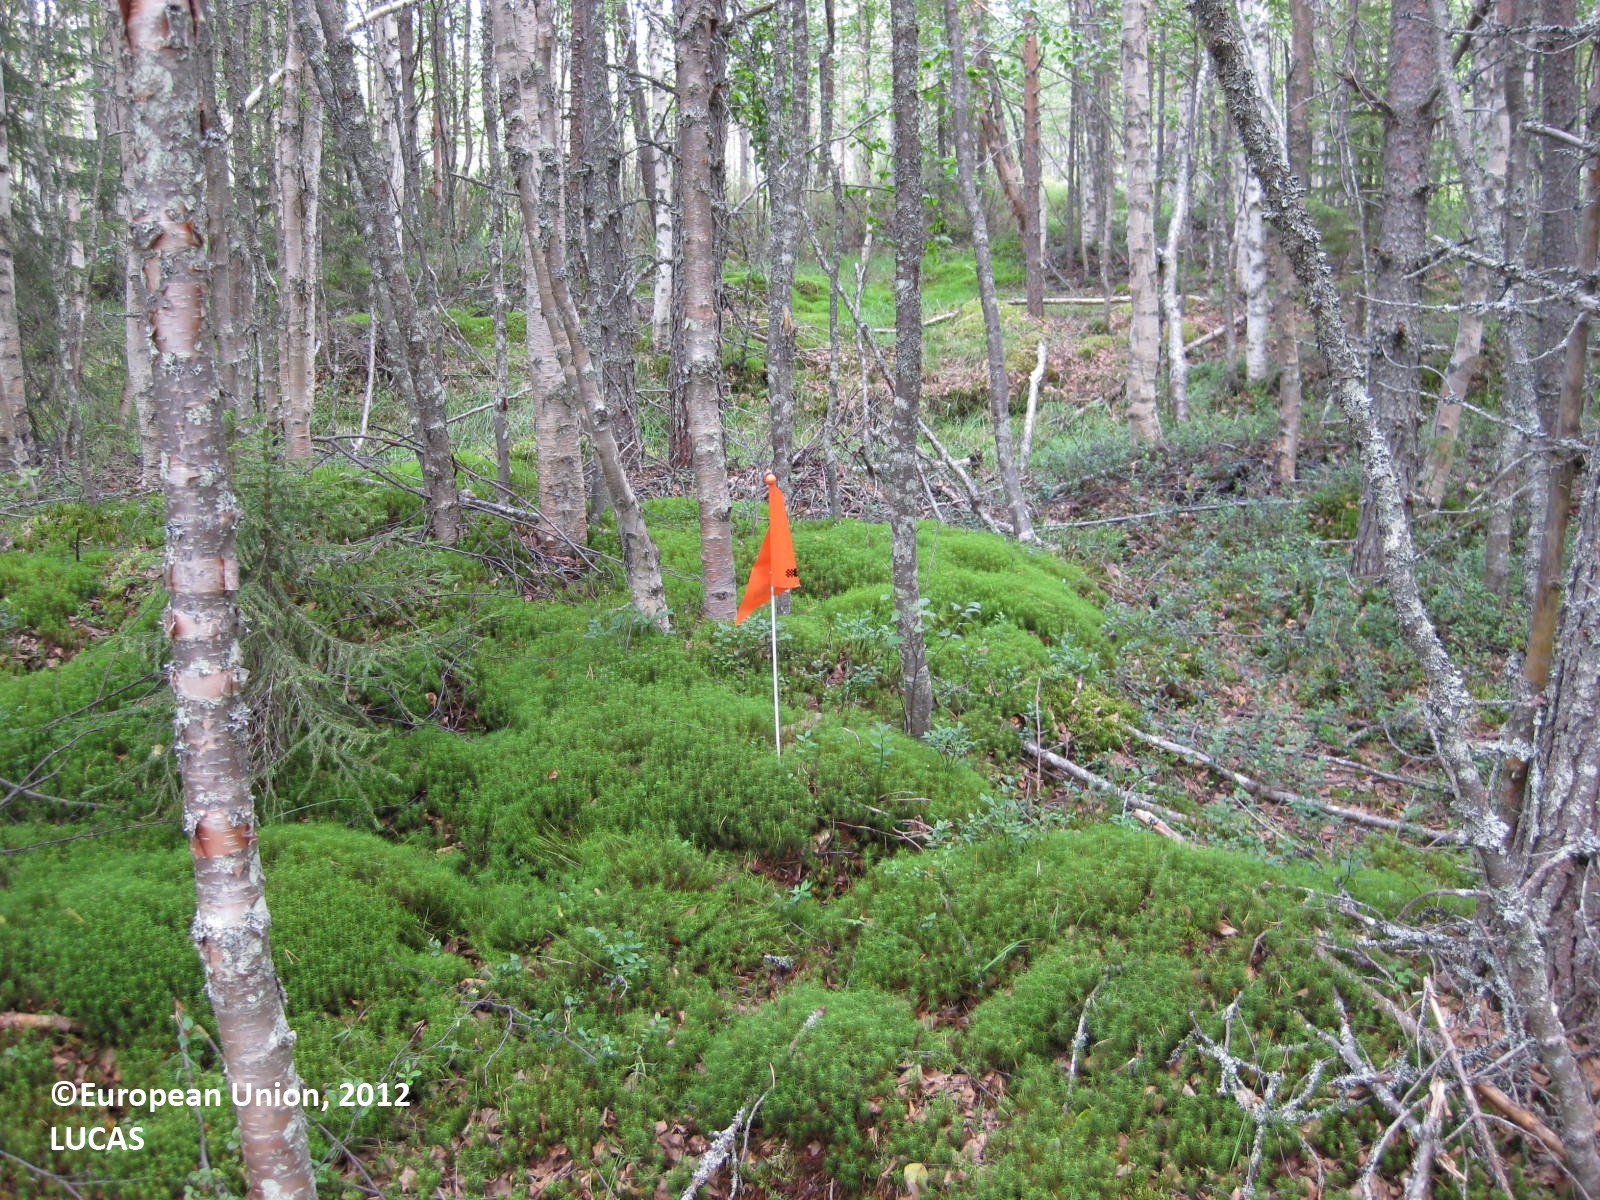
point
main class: Woodland
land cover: Pine dominated mixed woodland
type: boreal forest
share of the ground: > 75 %
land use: Forestry
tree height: > 5 m
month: August
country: FI
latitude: 66.4060
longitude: 28.4376
